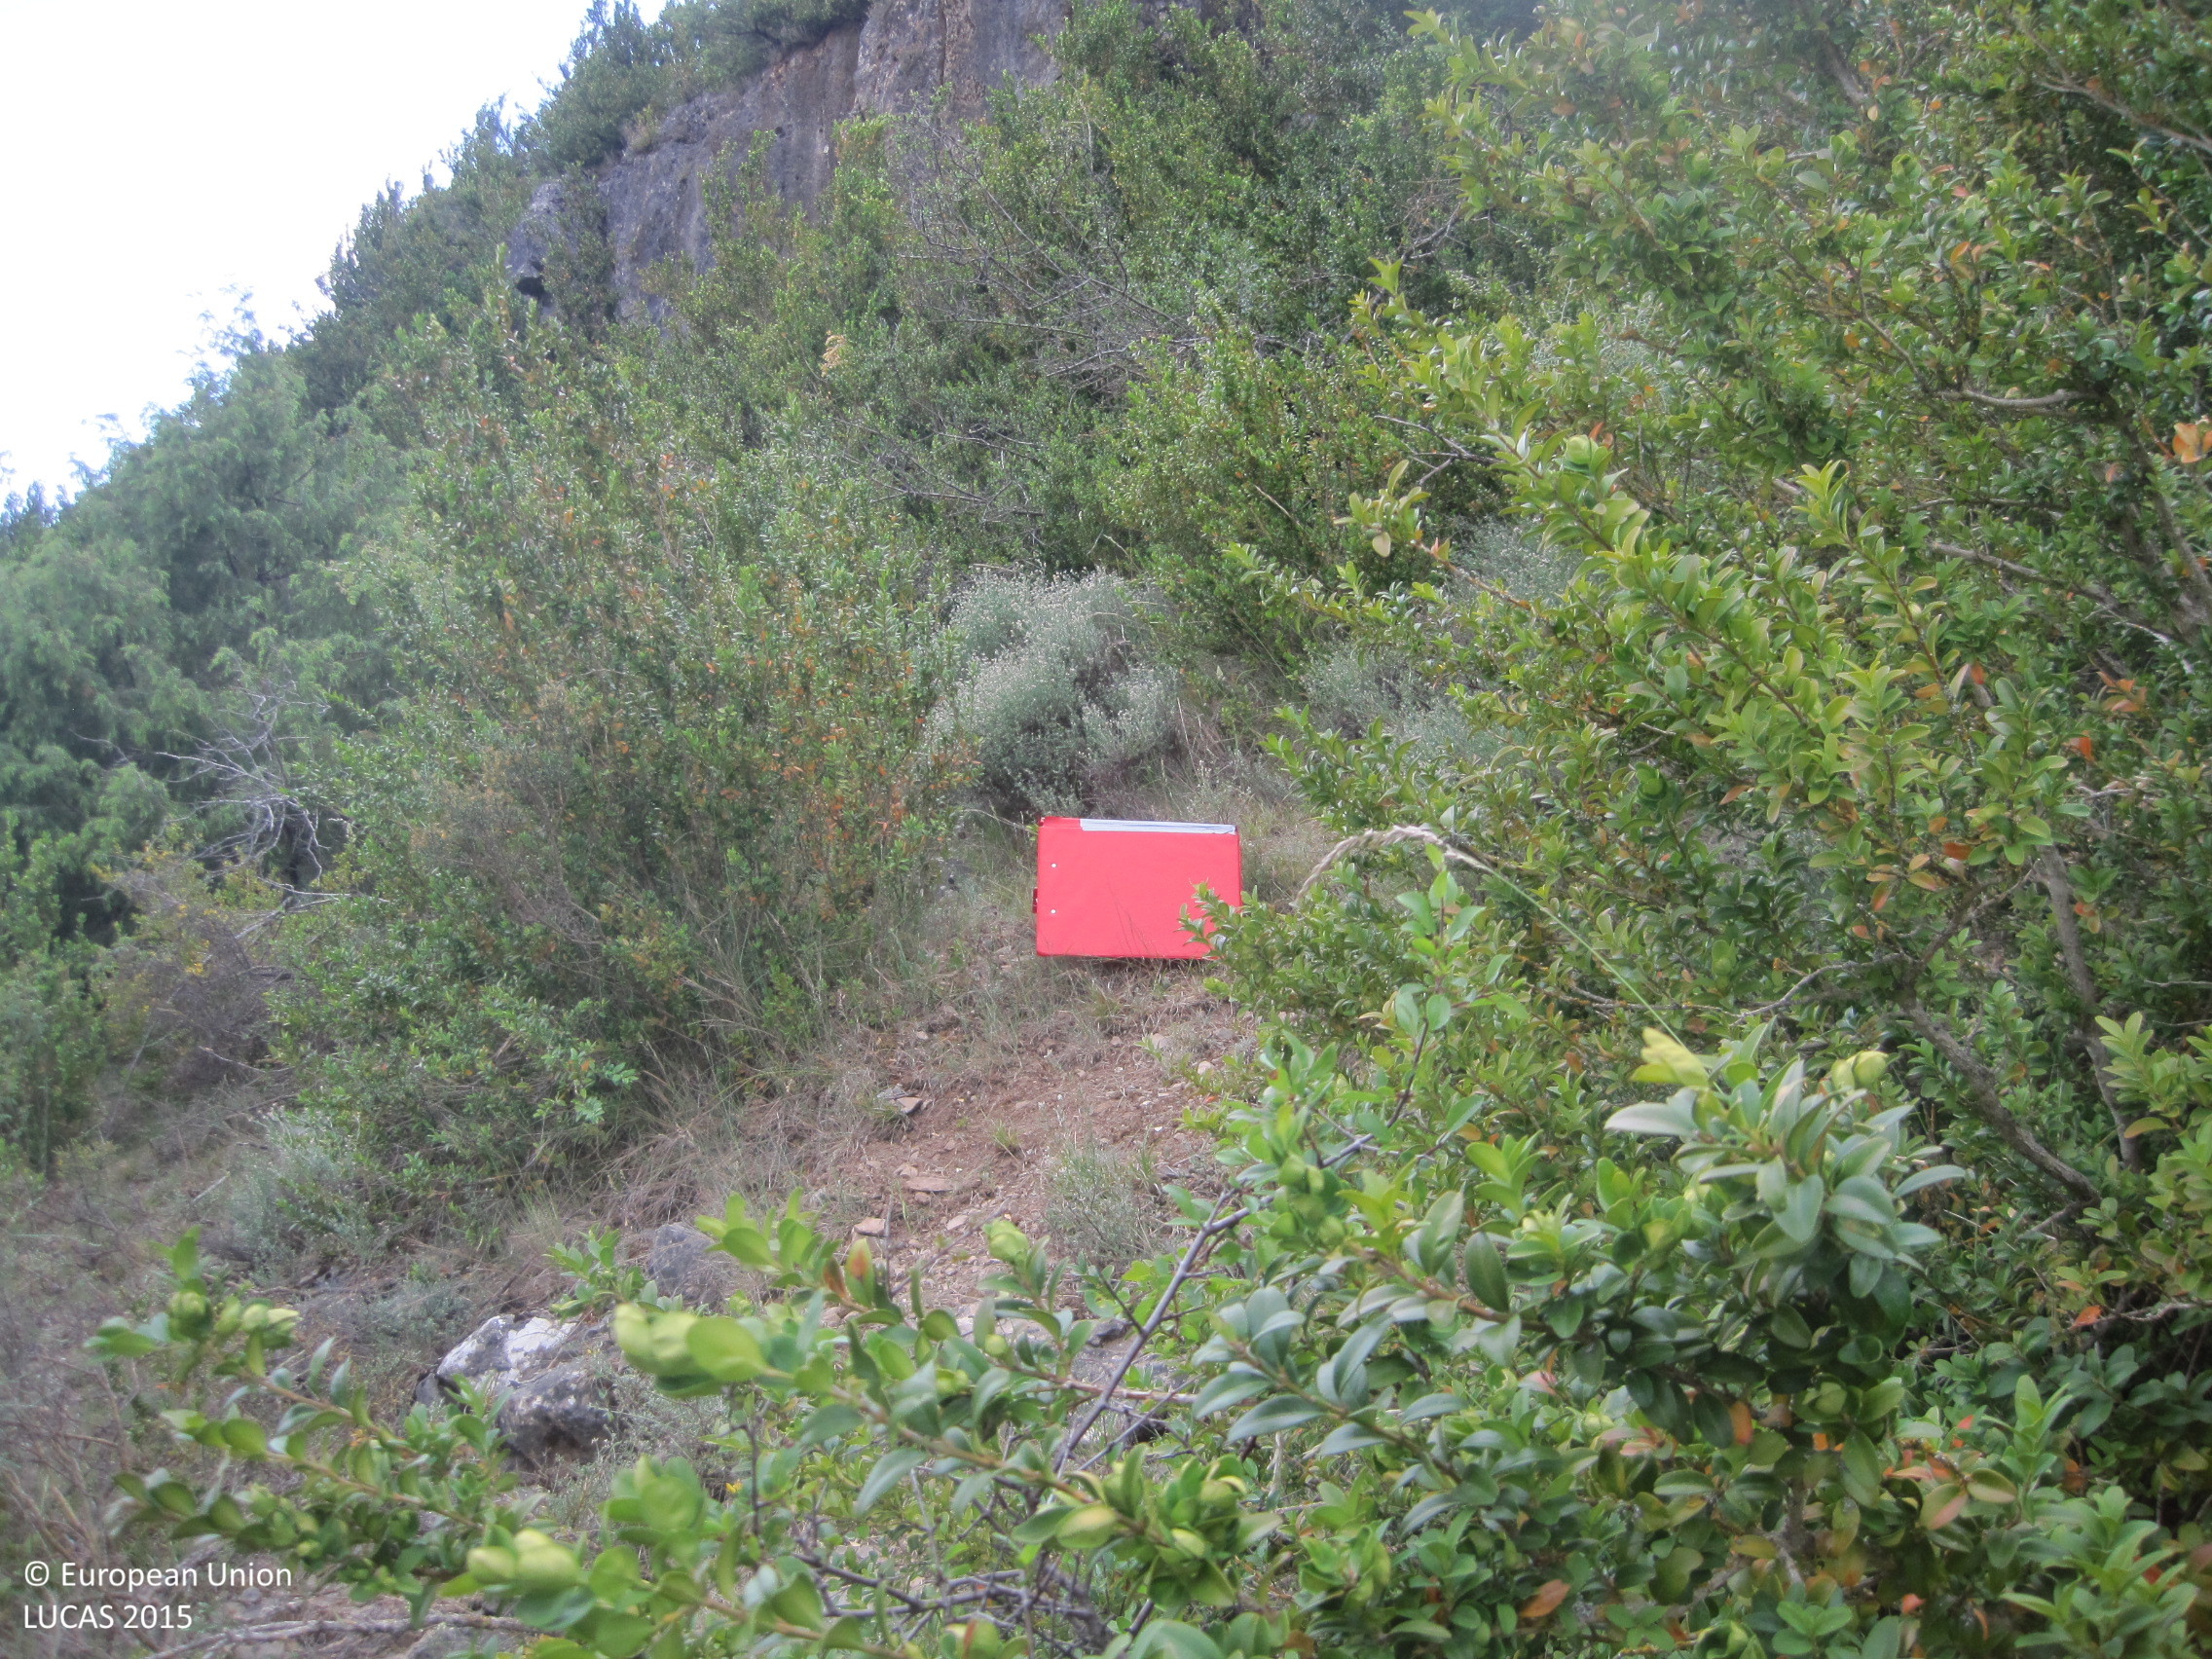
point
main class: Shrubland
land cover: Shrubland without tree cover
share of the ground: > 75 %
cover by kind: shrubs 50 %, herbaceous plants 30 %, unconsolidated bare surface 20 %
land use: Agriculture (excluding fallow land and kitchen gardens)
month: June
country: ES
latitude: 42.7015
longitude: -1.2286
